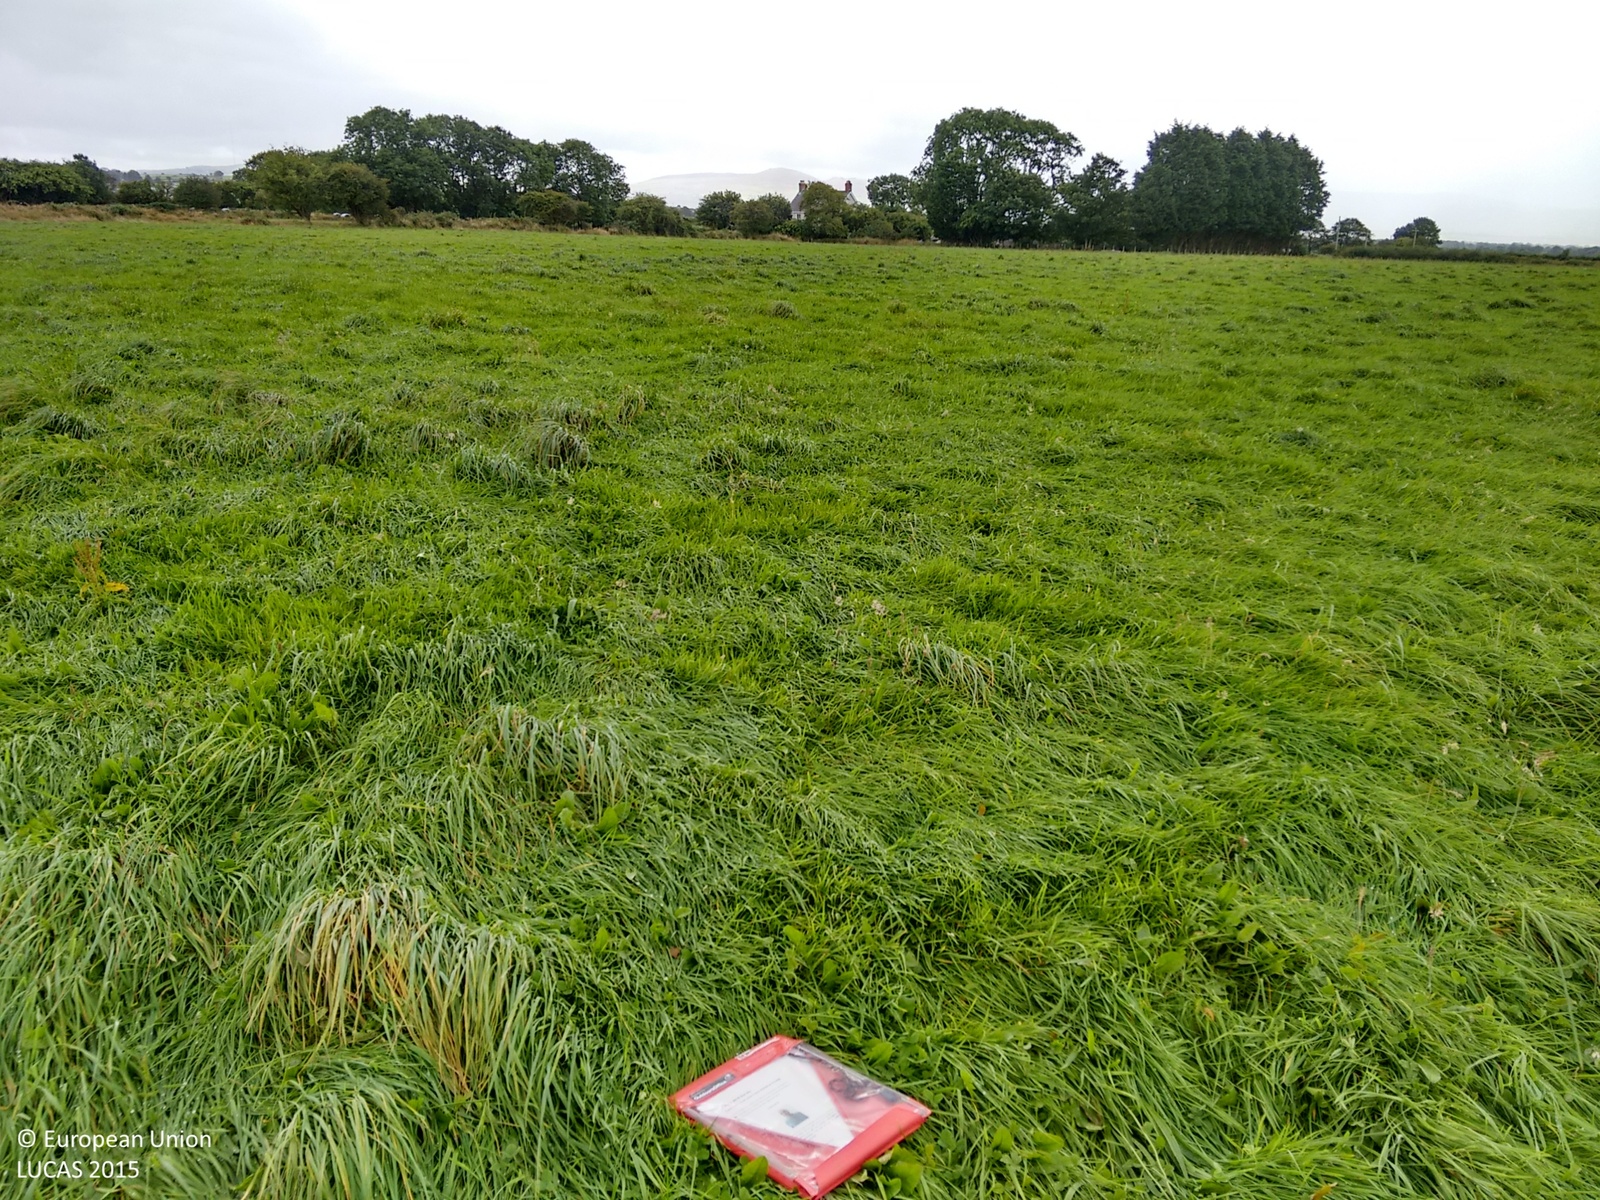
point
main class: Grassland
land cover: Grassland without tree/shrub cover
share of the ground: > 75 %
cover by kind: herbaceous plants 100 %
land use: Agriculture (excluding fallow land and kitchen gardens)
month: August
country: GB
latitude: 52.0123
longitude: -4.6347
